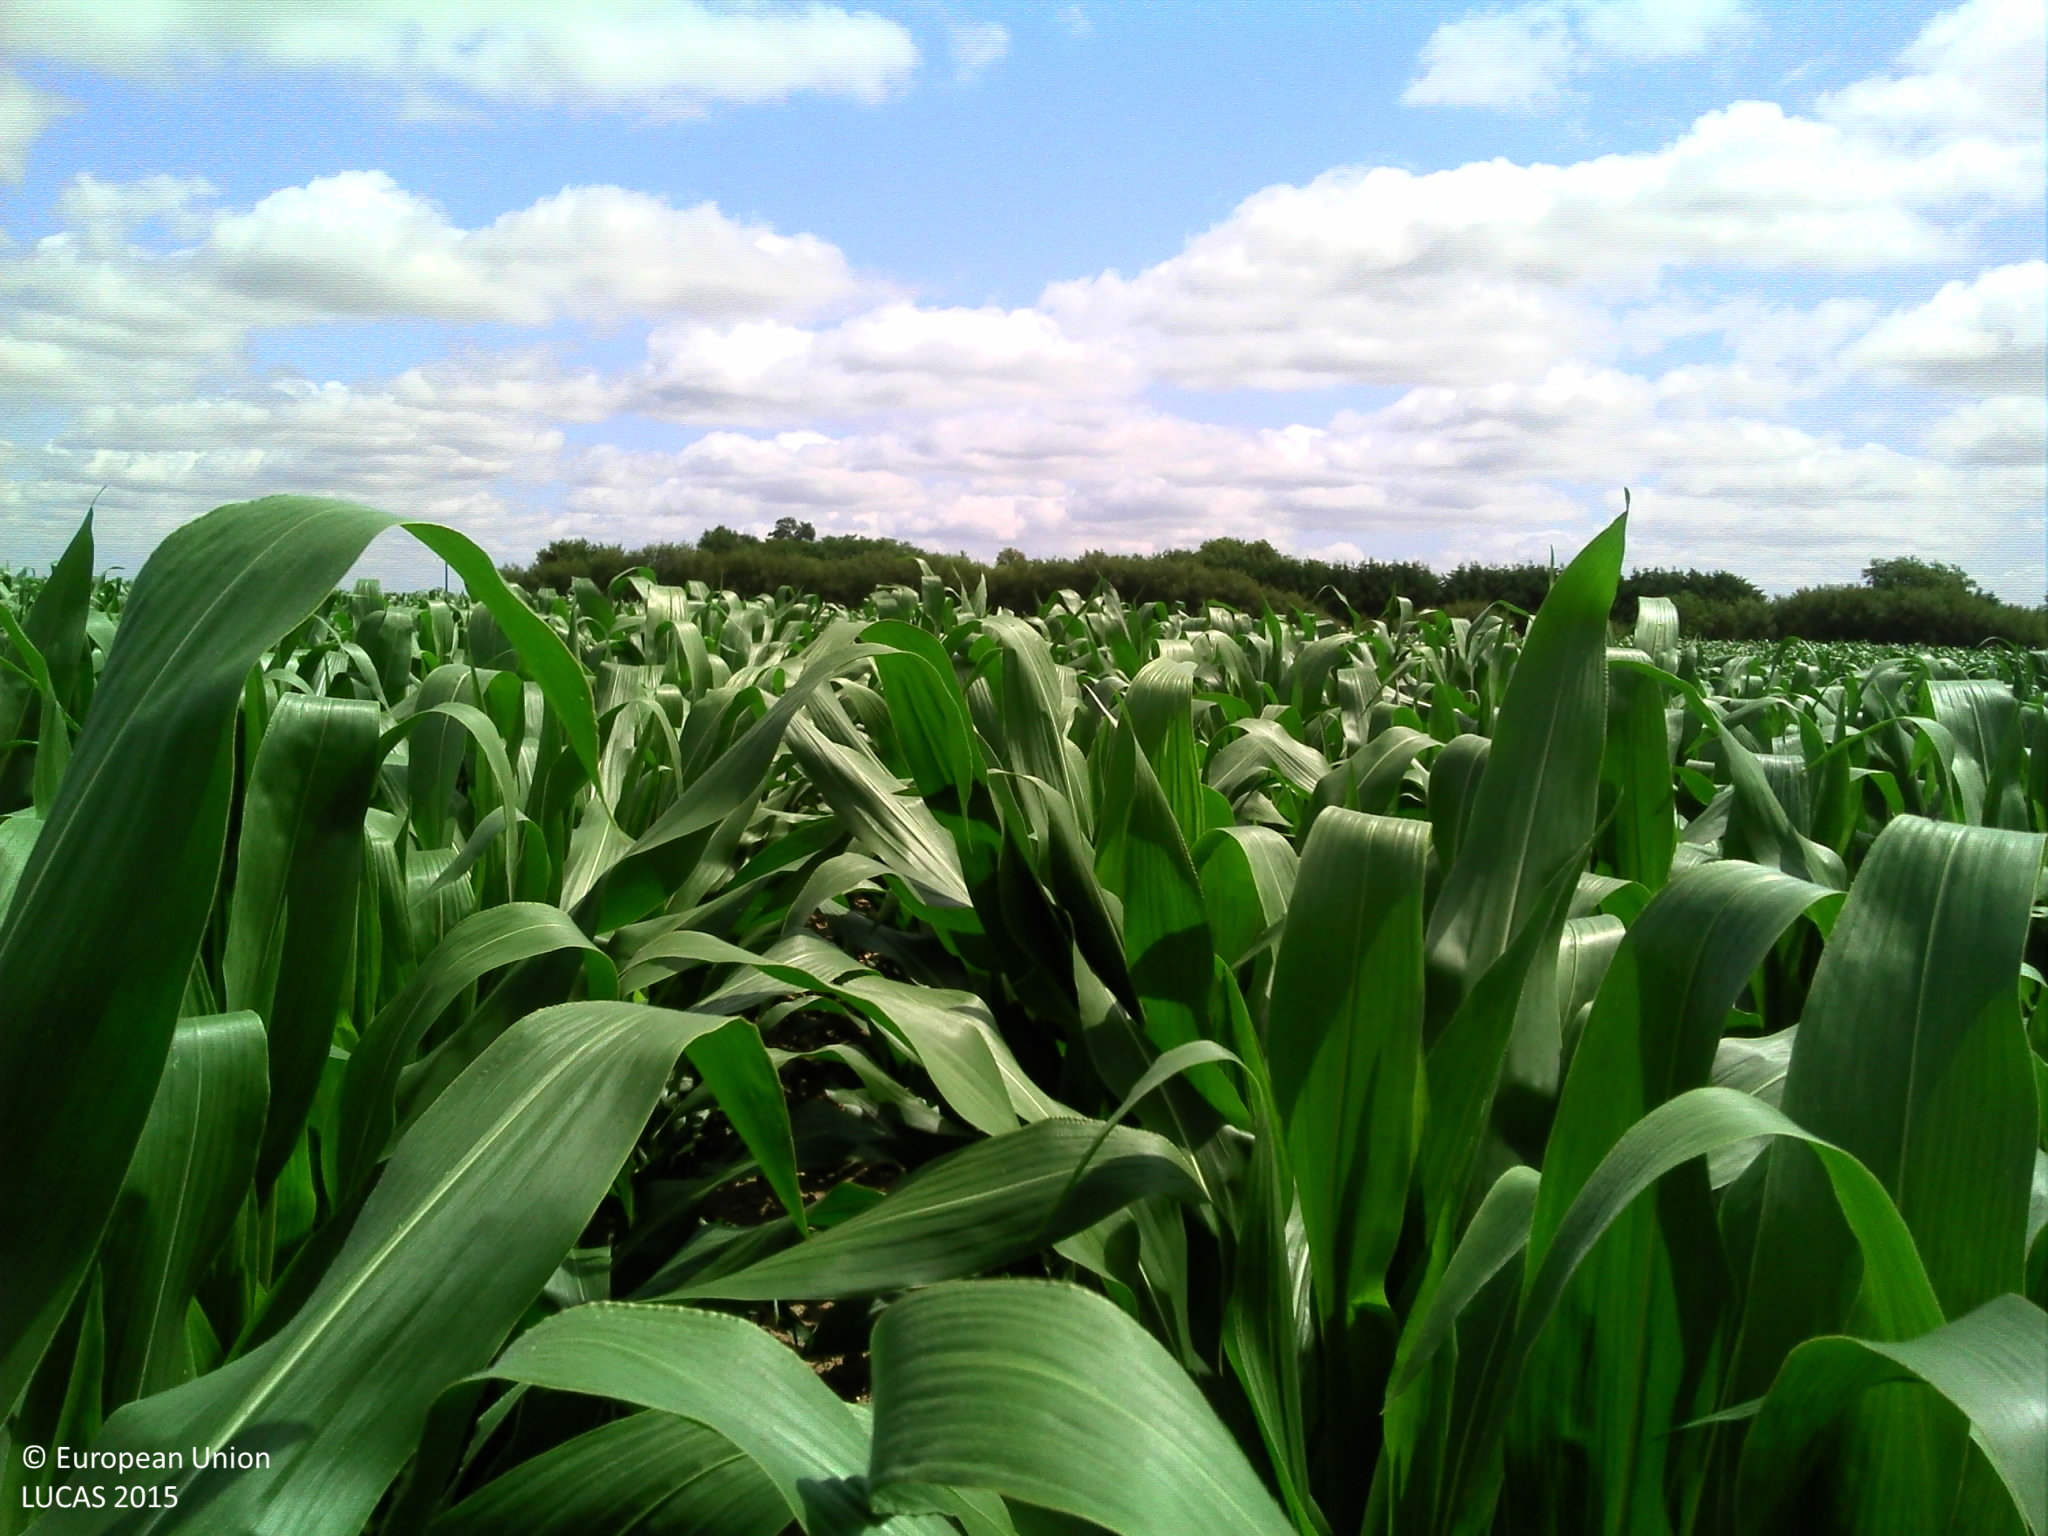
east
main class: Cropland
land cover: Maize
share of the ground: 50 - 75 %
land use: Agriculture (excluding fallow land and kitchen gardens)
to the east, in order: Maize; Ditches and canals; Grass margins; Tracks; Grass margins; Ditches and canals; Broadleaved woodland; Fences; Grassland without tree/shrub cover; Fences; Broadleaved woodland; Fences; Grassland without tree/shrub cover; Fences; Abandoned hedges
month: July
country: FR
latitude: 47.6566
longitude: -1.8315
